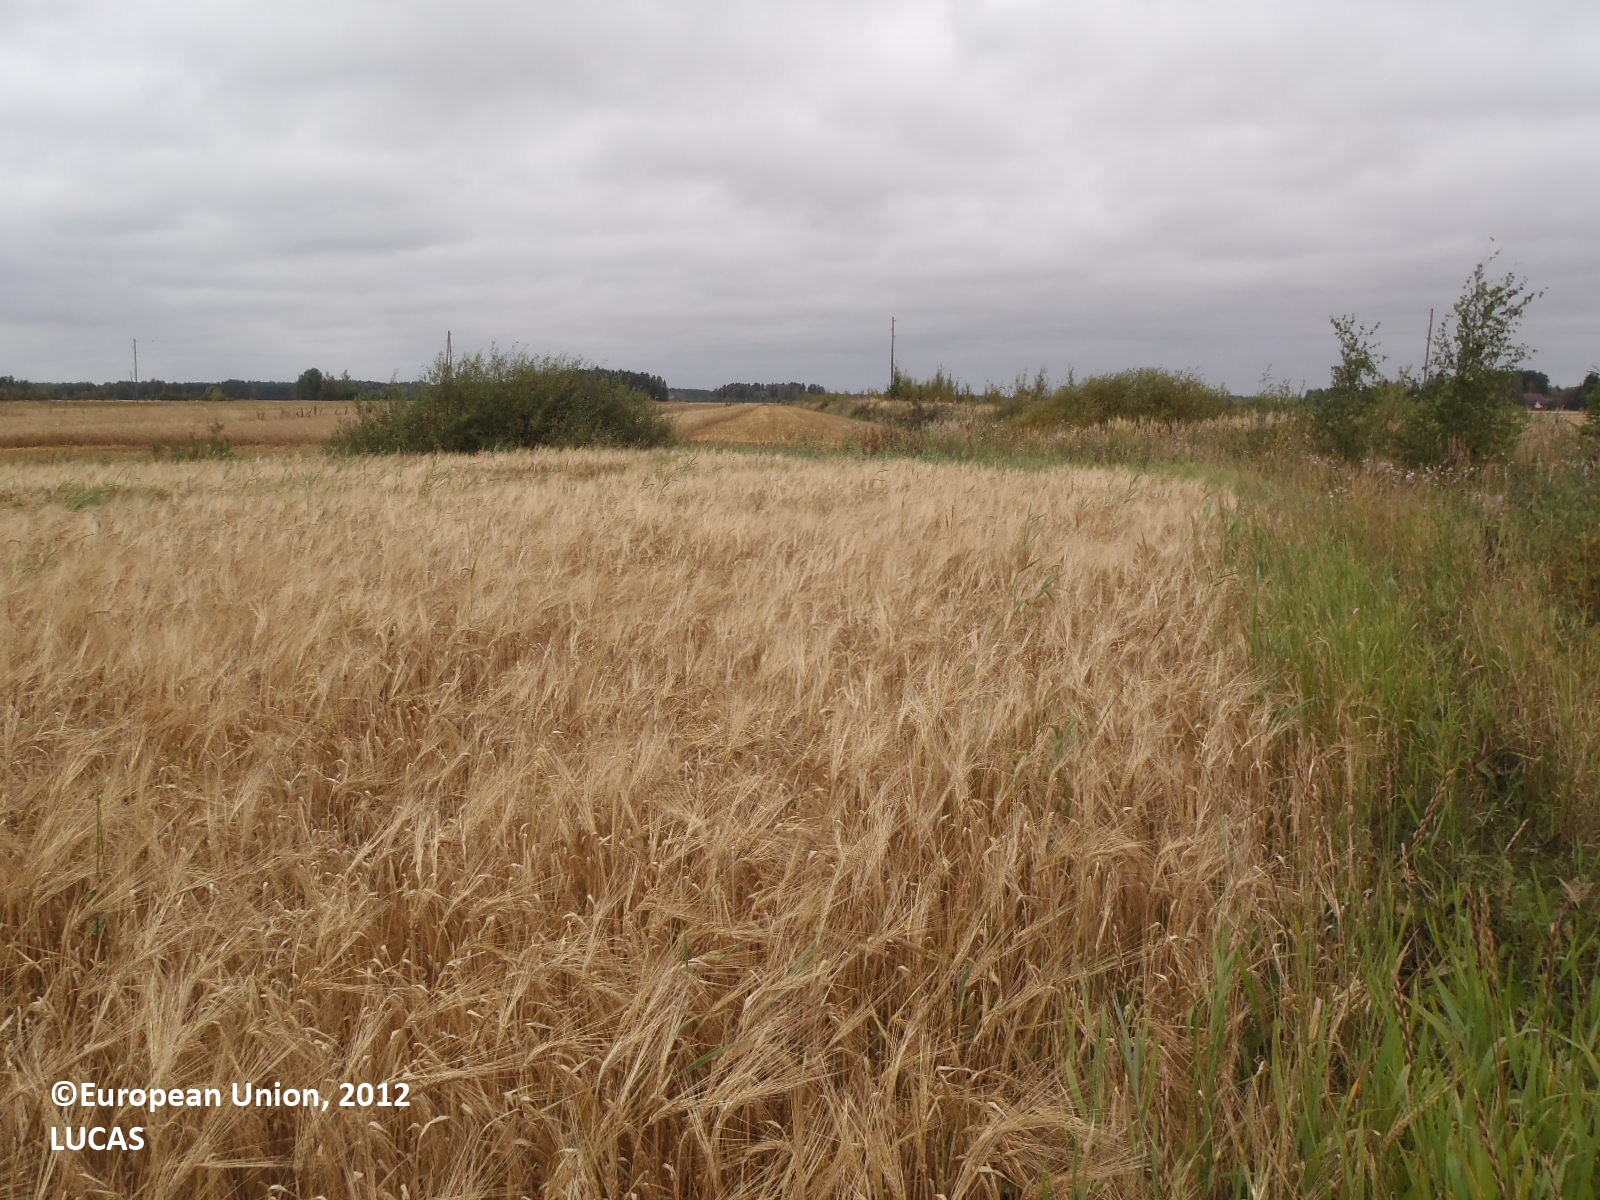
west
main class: Cropland
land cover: Barley
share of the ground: > 75 %
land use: Agriculture (excluding fallow land and kitchen gardens)
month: September
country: FI
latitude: 60.8001
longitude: 22.8072
